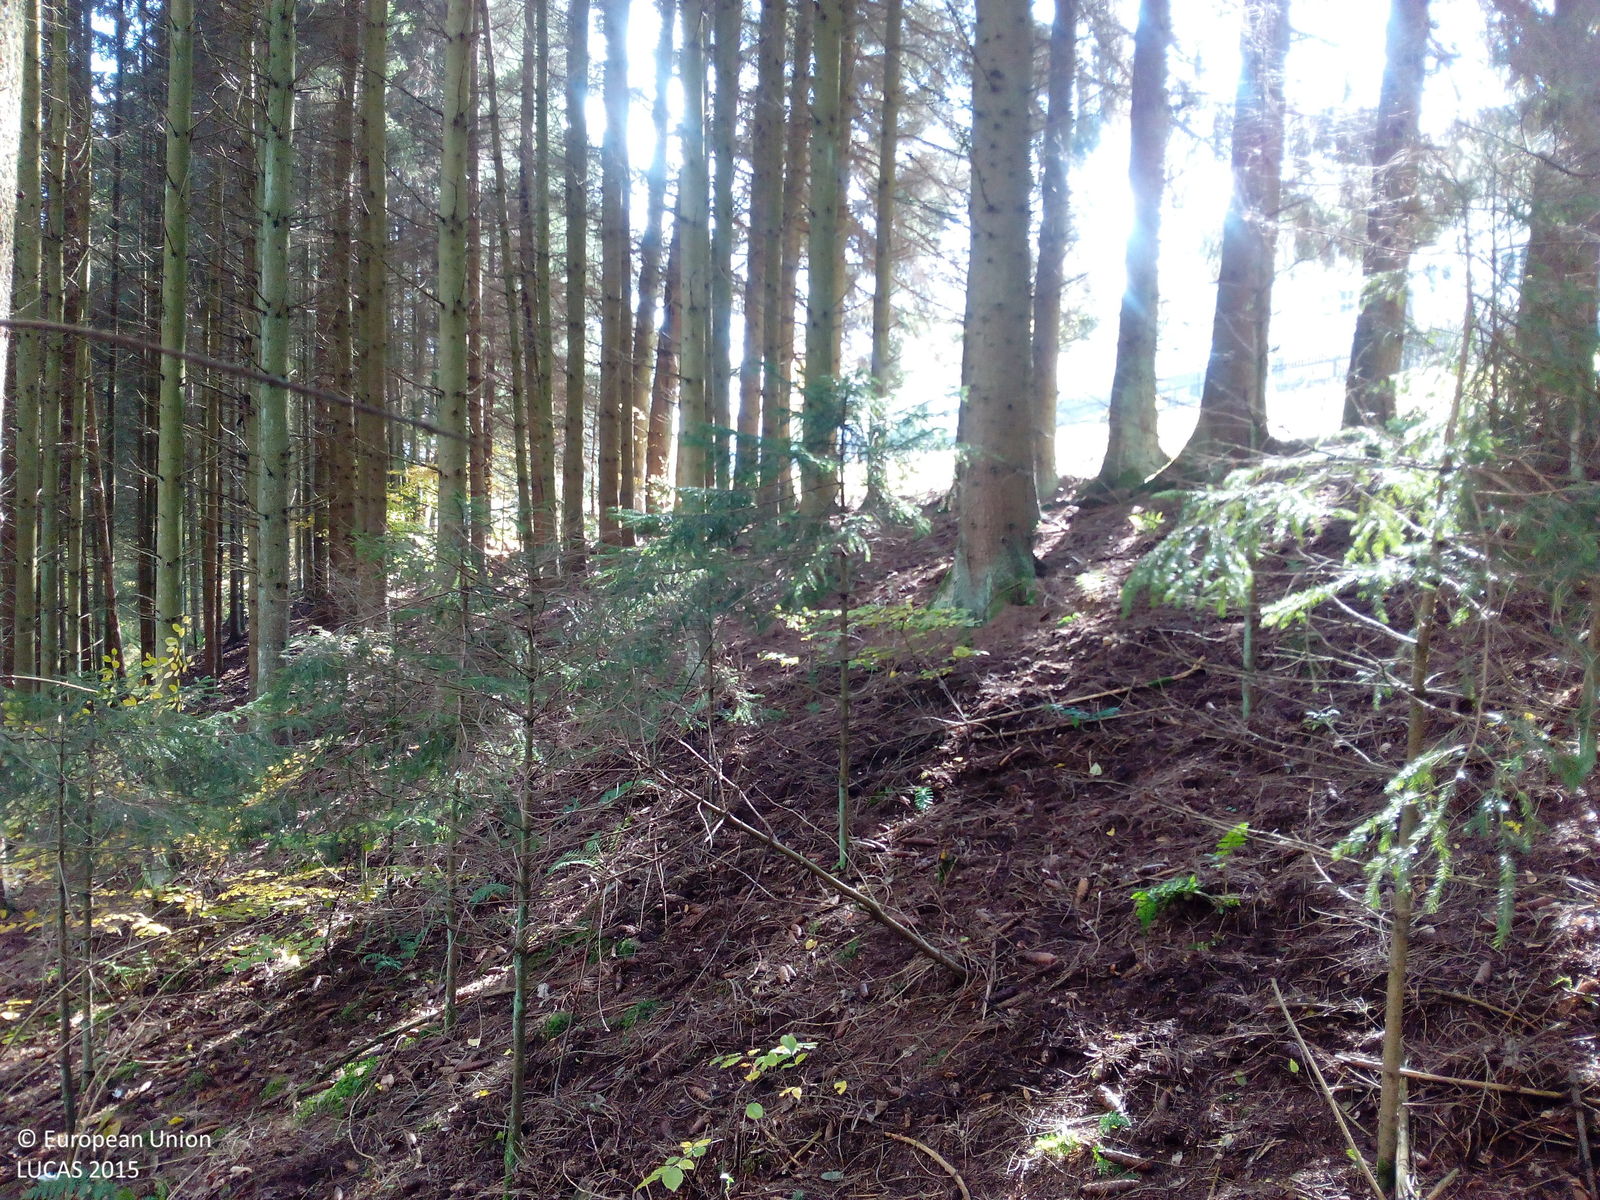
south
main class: Woodland
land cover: Spruce dominated coniferous woodland
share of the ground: 50 - 75 %
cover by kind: coniferous forest trees 65 %, unconsolidated bare surface 15 %, lichens and mosses 10 %, broadleaved forest trees 5 %, shrubs 5 %
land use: Forestry
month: October
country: DE
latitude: 50.3460
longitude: 9.8736
